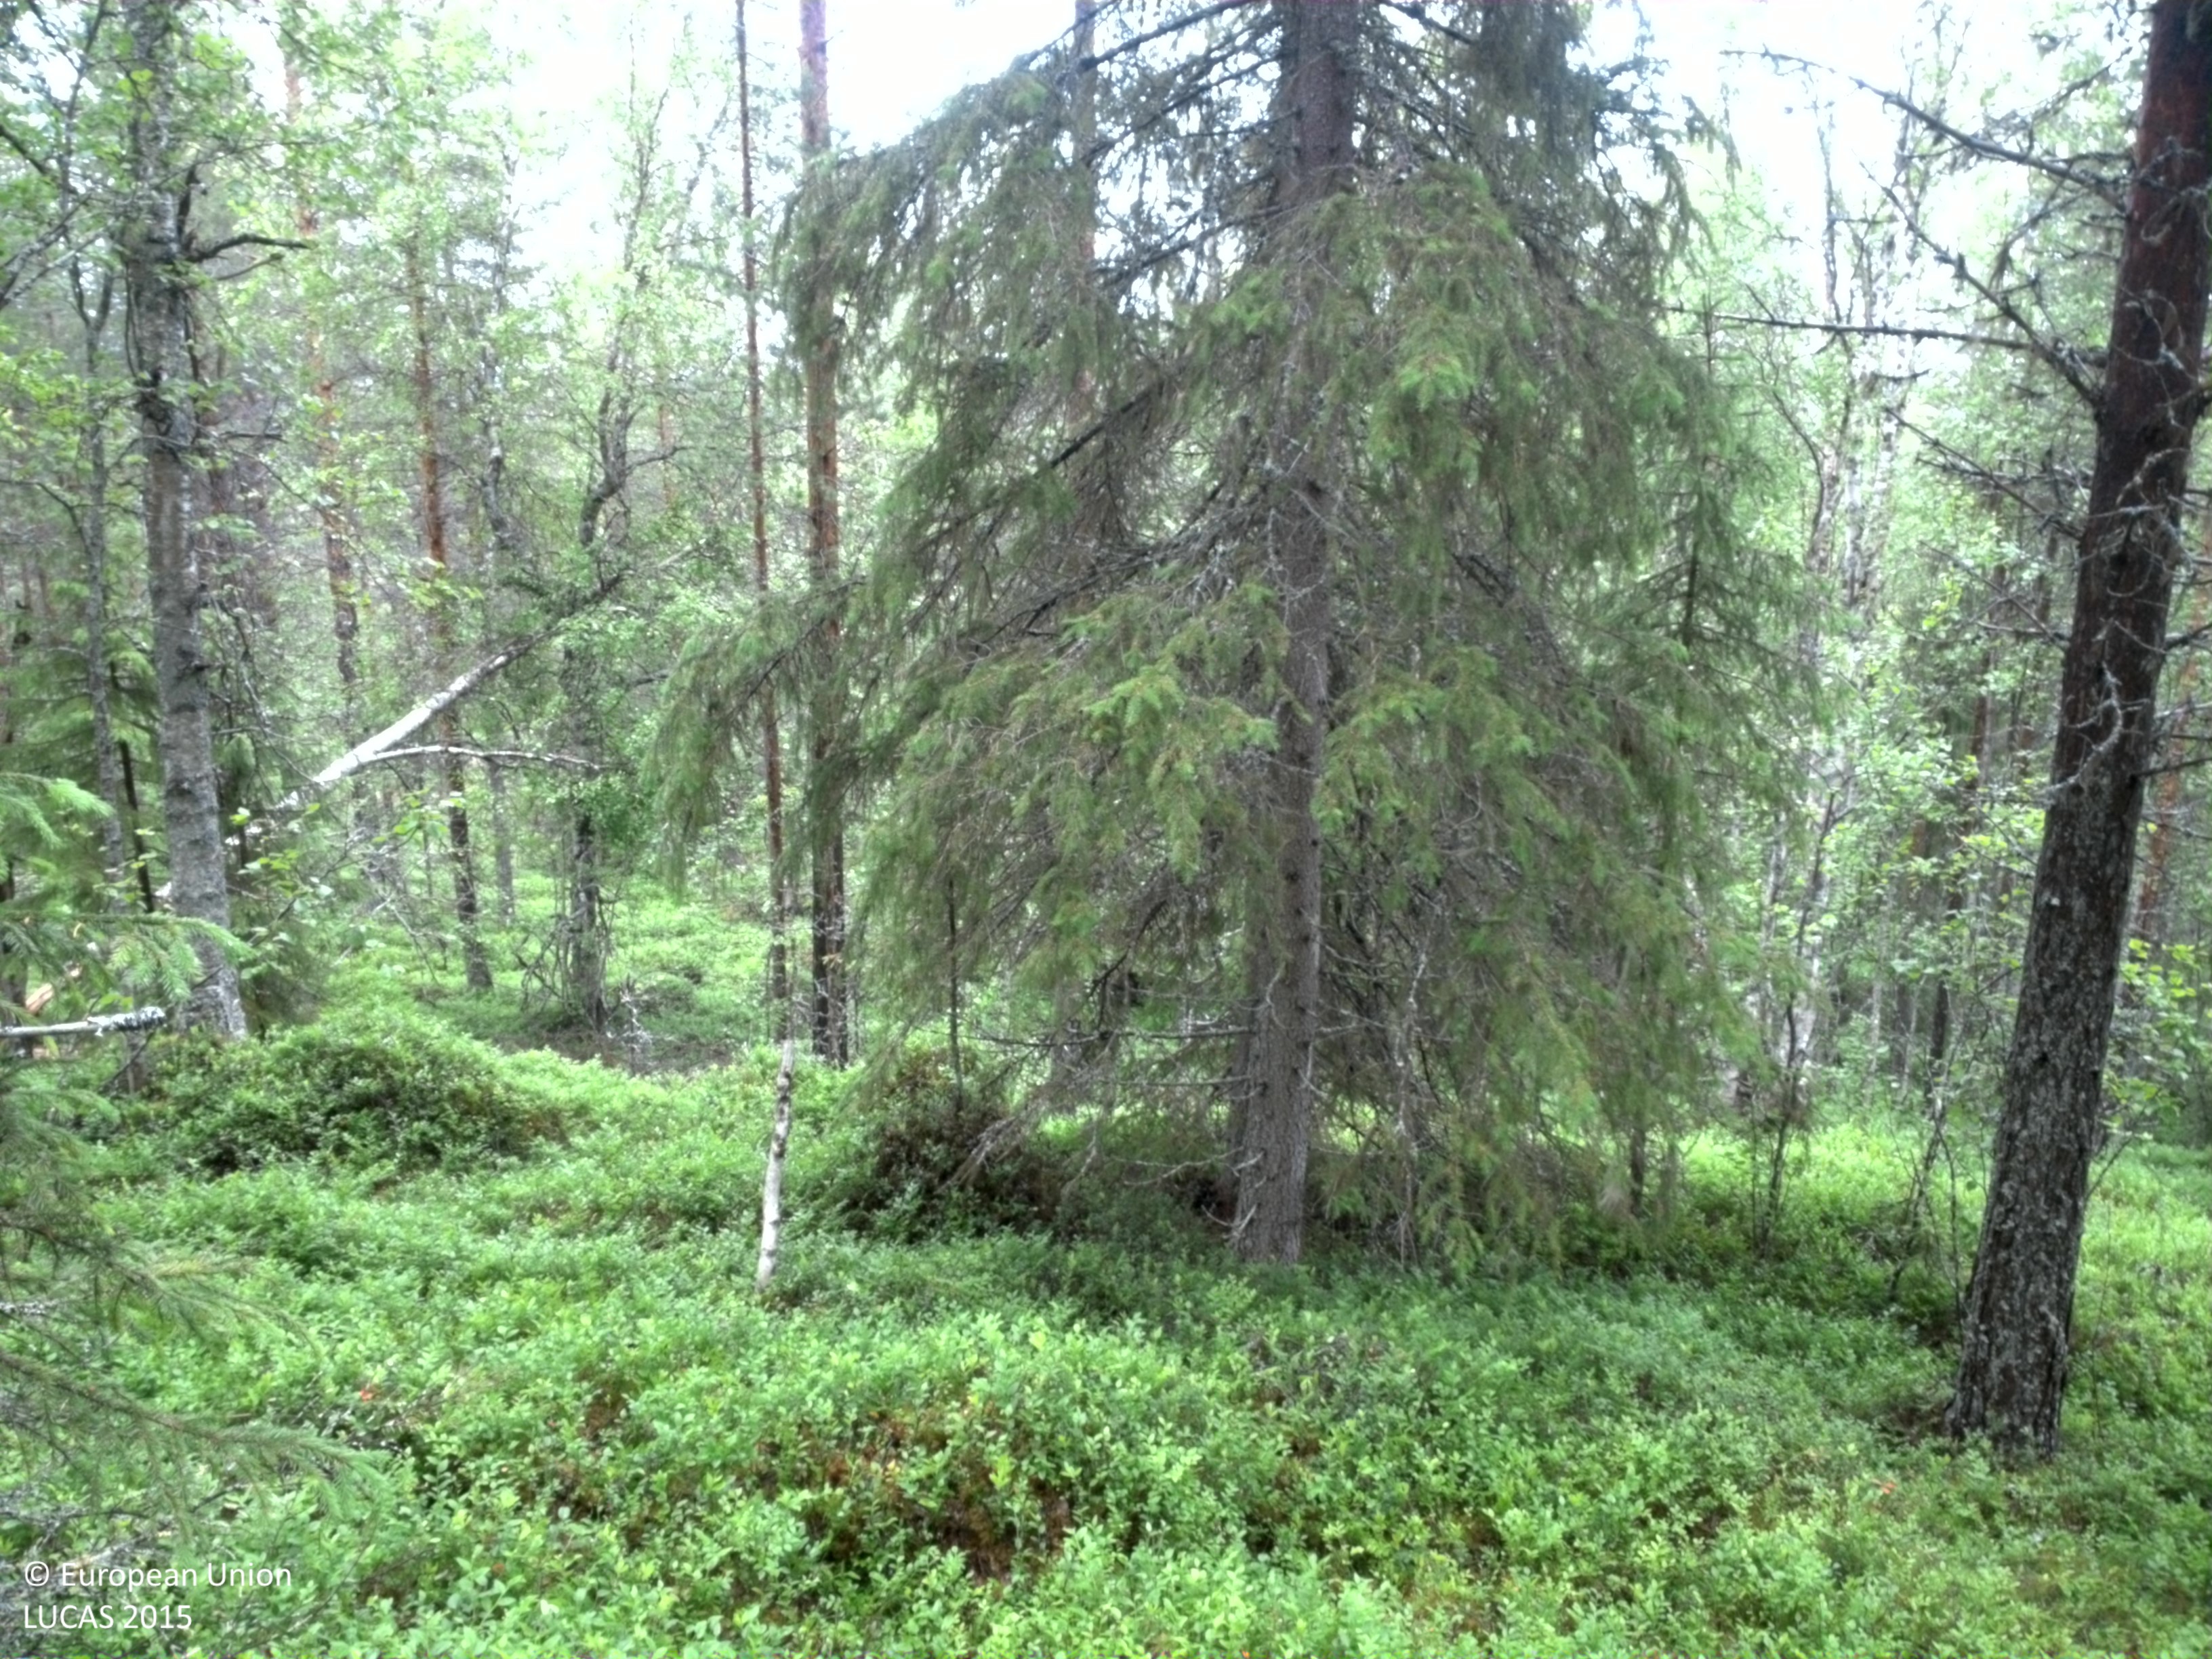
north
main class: Woodland
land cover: Pine dominated coniferous woodland
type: hemiboreal forest and nemoral coniferous forest and mixed broadleaved-coniferous forest
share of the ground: 50 - 75 %
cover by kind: coniferous forest trees 65 %, shrubs 20 %, broadleaved forest trees 10 %, lichens and mosses 5 %
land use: Forestry
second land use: Amenities, museums, leisure
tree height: > 5 m
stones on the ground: 10 - 25 %
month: July
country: SE
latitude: 64.6207
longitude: 18.2267
